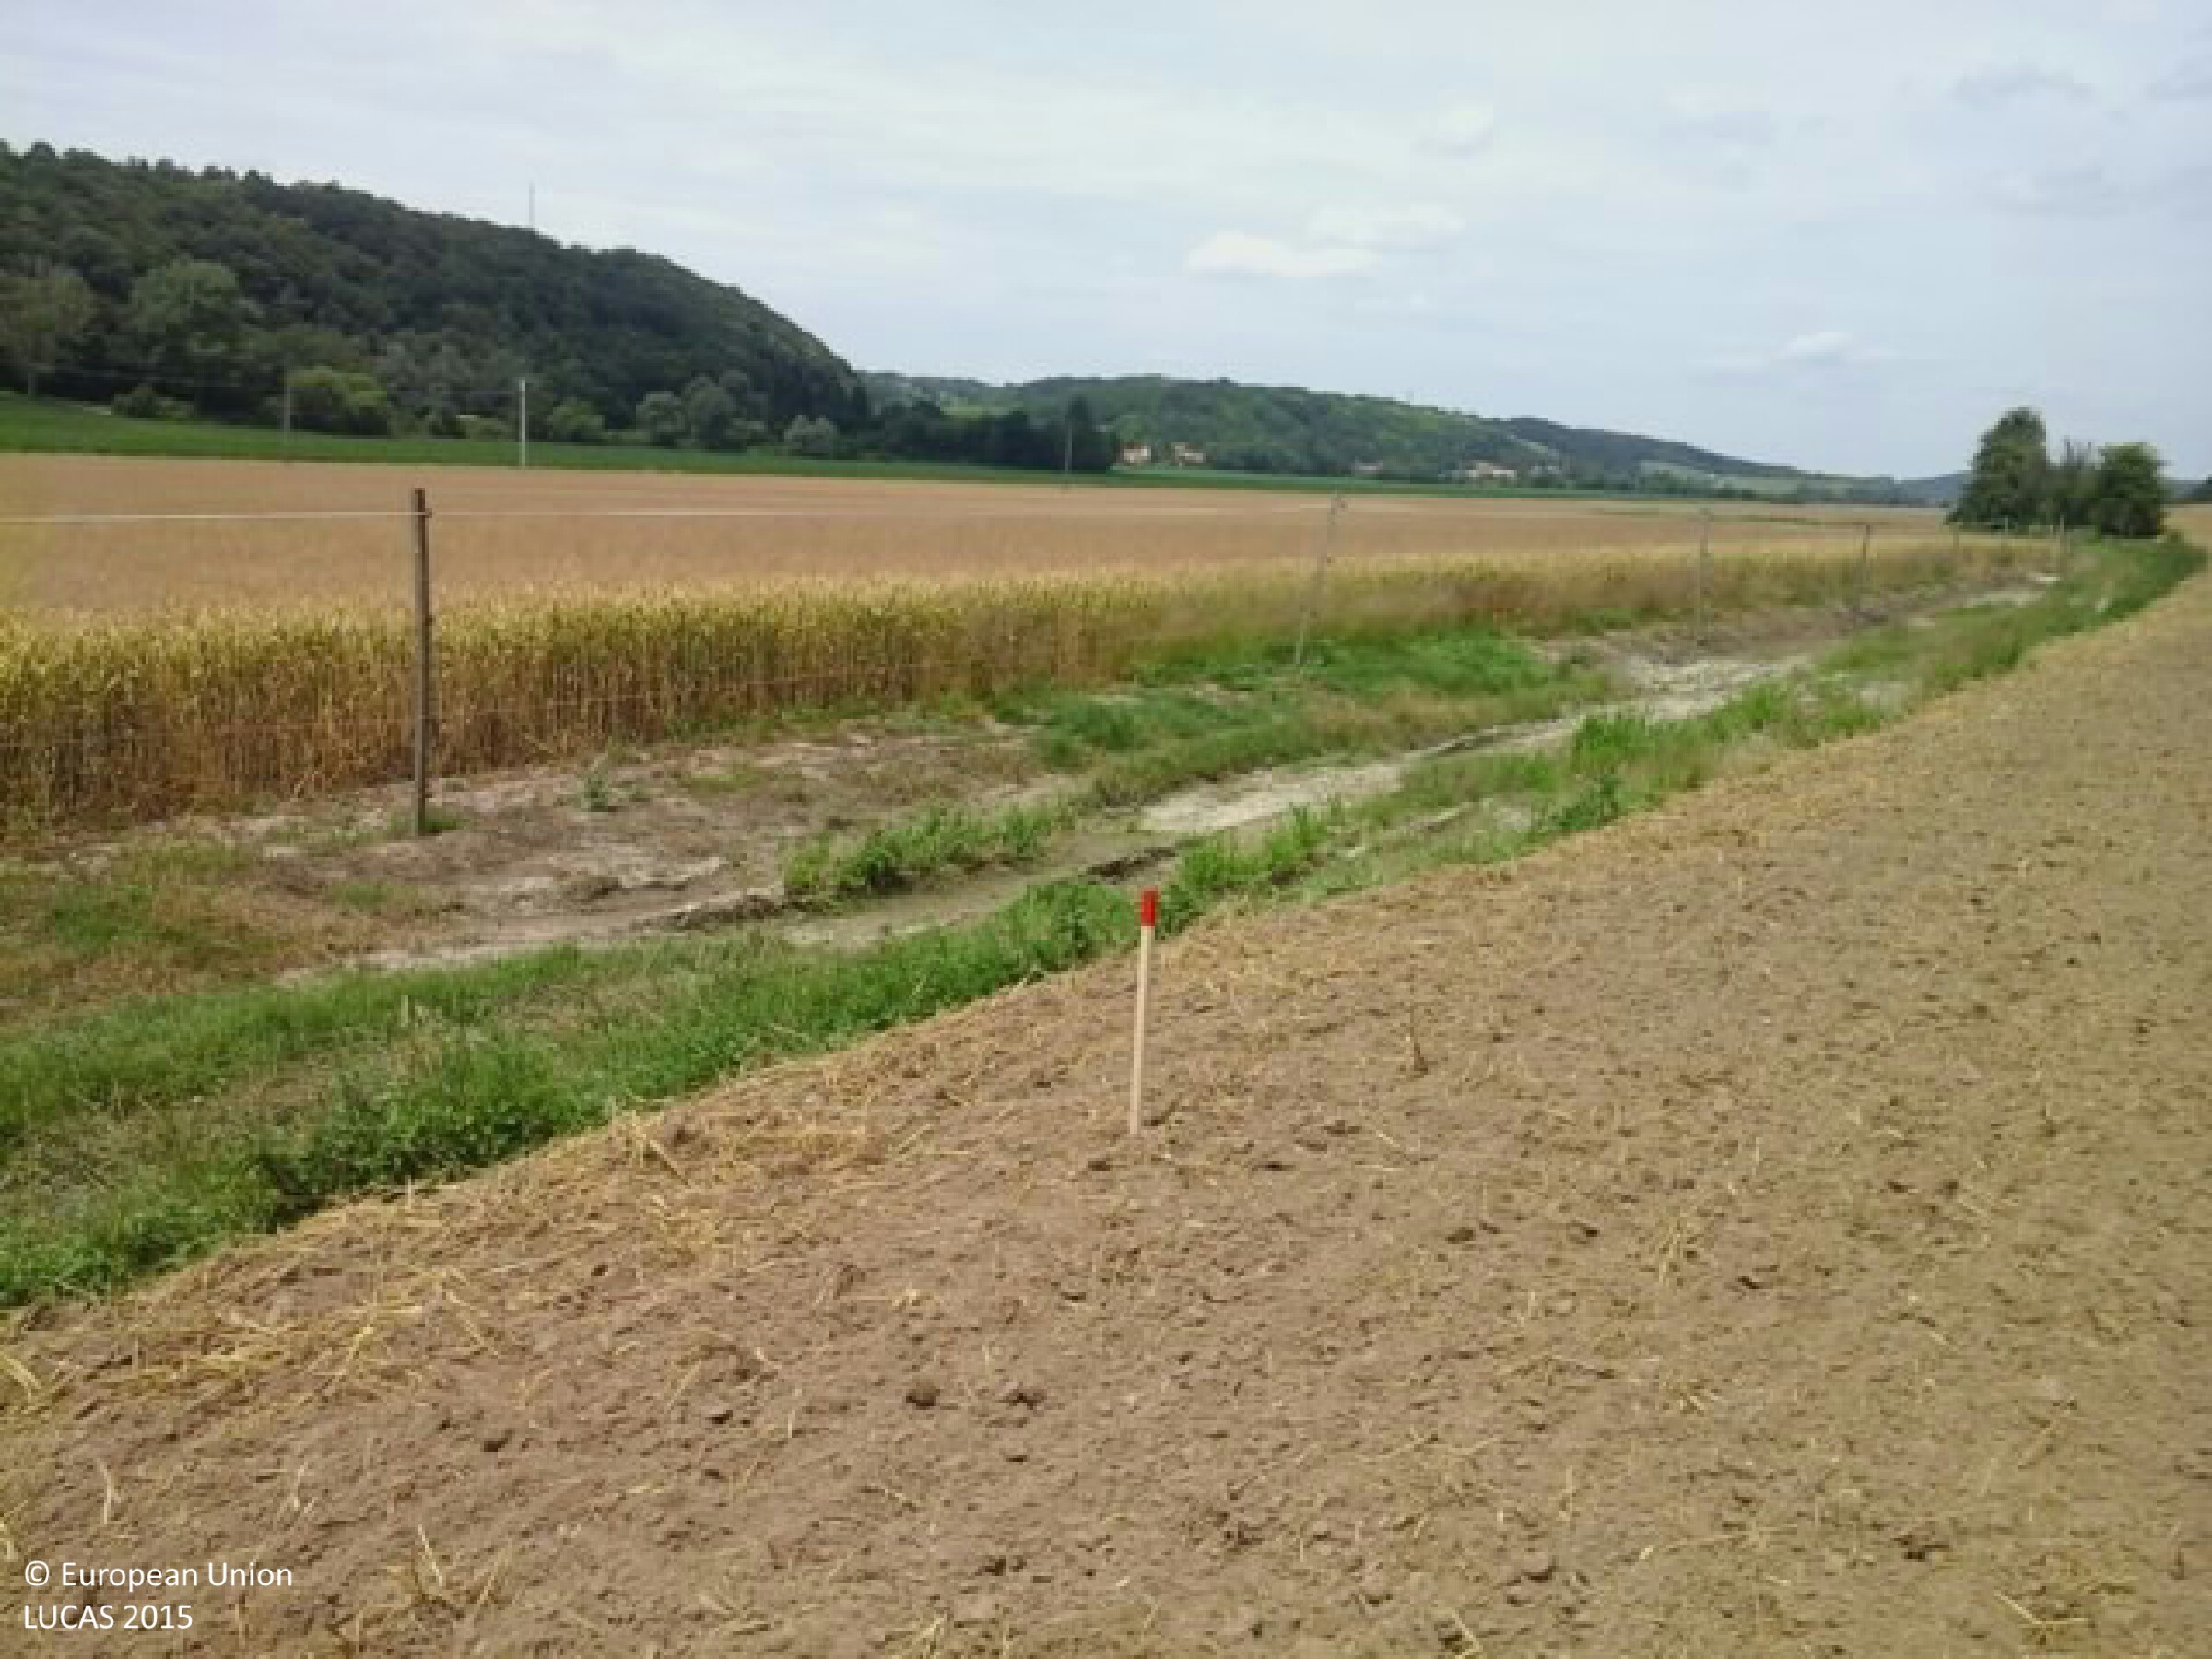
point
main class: Cropland
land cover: Common wheat
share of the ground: < 10 %
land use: Agriculture (excluding fallow land and kitchen gardens)
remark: Harvested field
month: June
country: HU
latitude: 46.2950
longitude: 17.8859
